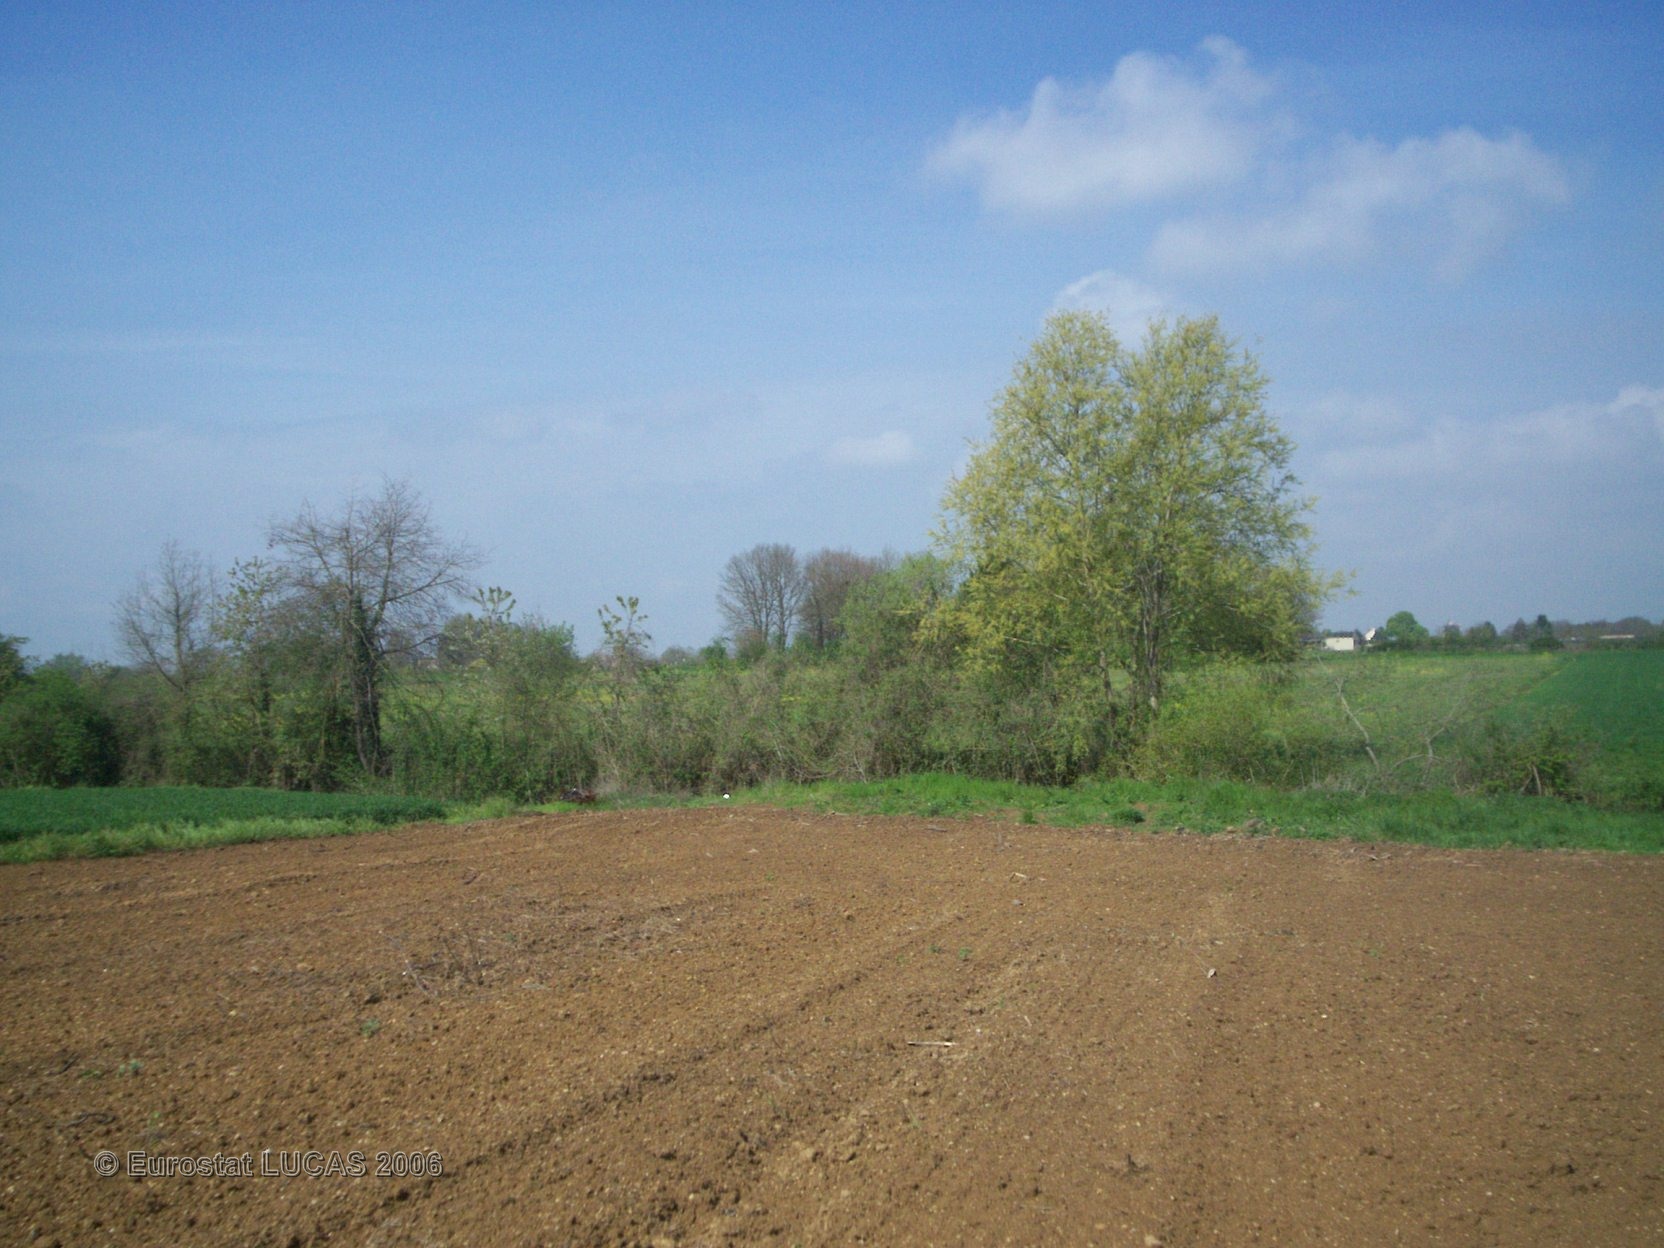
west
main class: Cropland
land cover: Sunflower
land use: Agriculture (excluding fallow land and kitchen gardens)
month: April
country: FR
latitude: 47.2430
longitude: -0.3728
